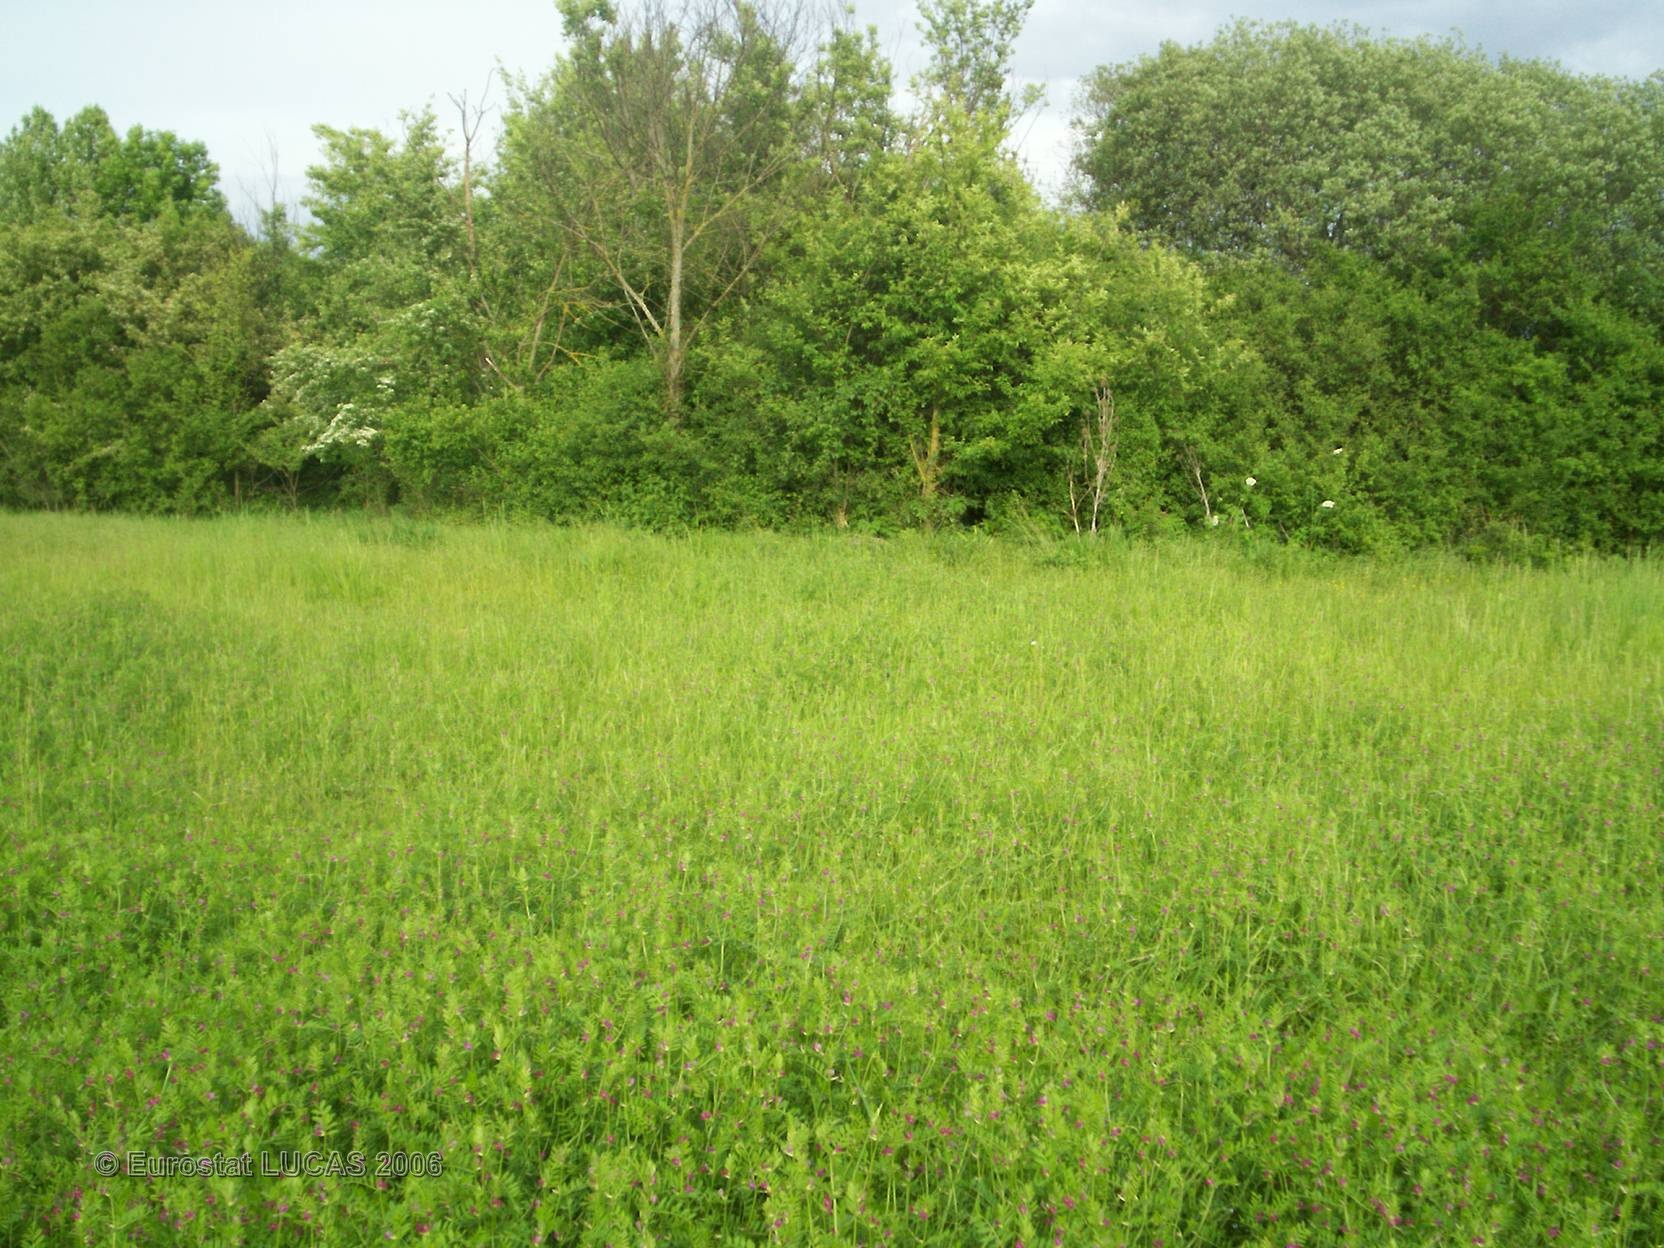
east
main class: Grassland
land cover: Grassland without tree/shrub cover
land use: Agriculture (excluding fallow land and kitchen gardens)
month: May
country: FR
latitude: 46.1545
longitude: 3.2269
